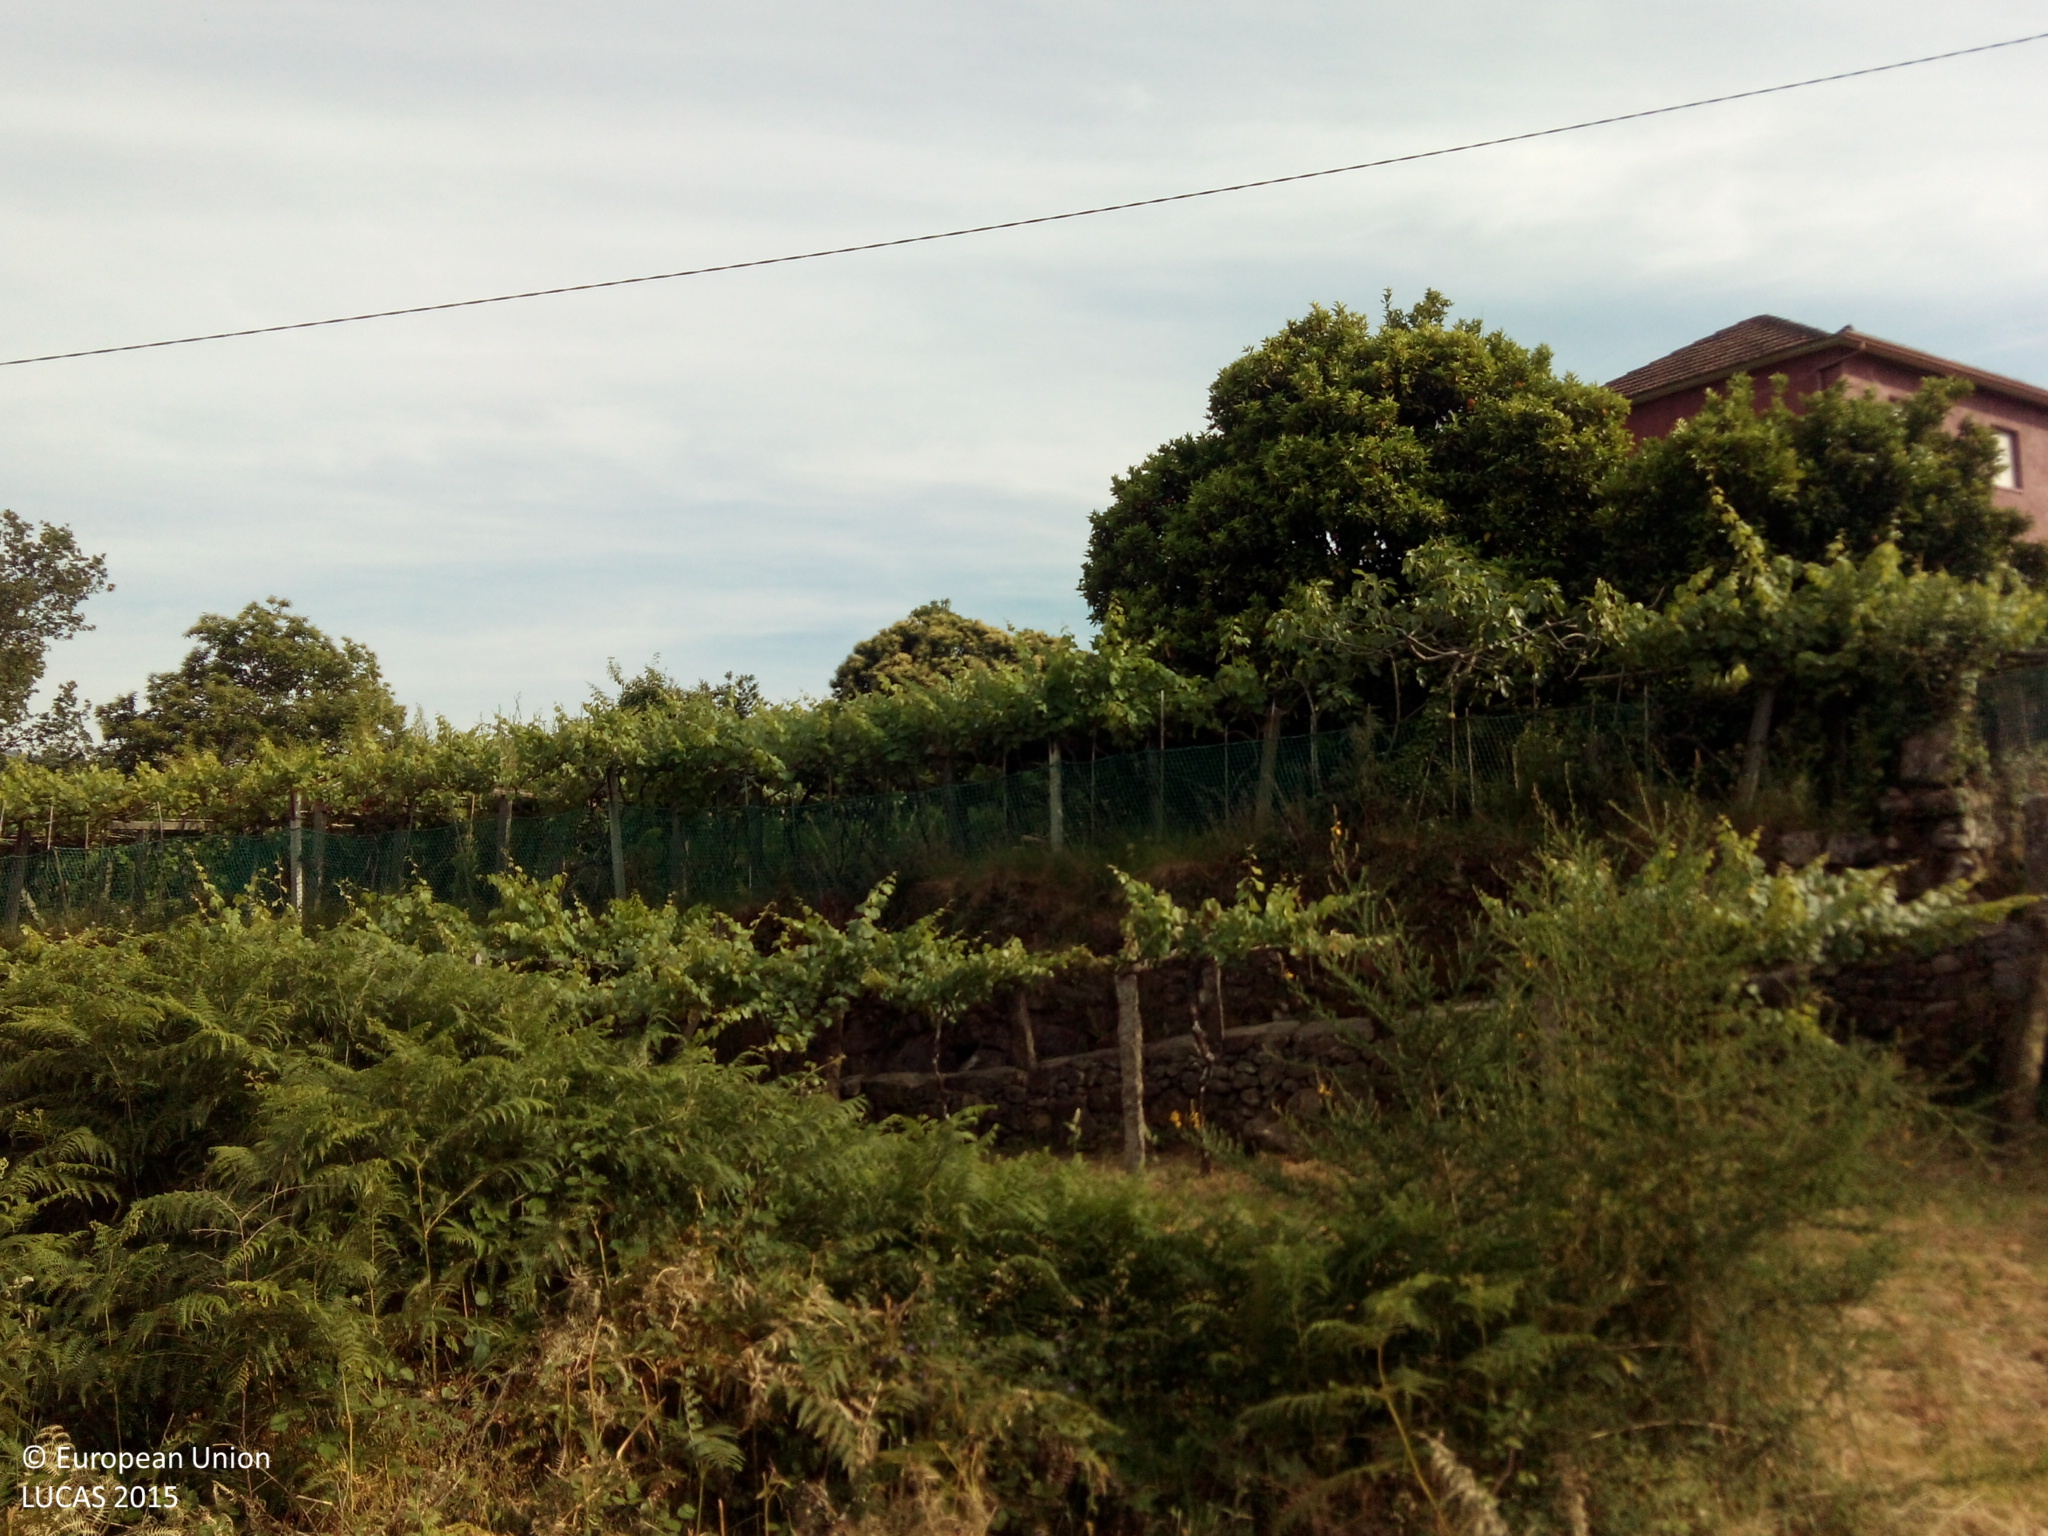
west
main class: Cropland
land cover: Vineyards
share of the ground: 50 - 75 %
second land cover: Grassland without tree/shrub cover
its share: 50 - 75 %
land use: Agriculture (excluding fallow land and kitchen gardens)
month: June
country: ES
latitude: 42.1170
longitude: -8.2893
